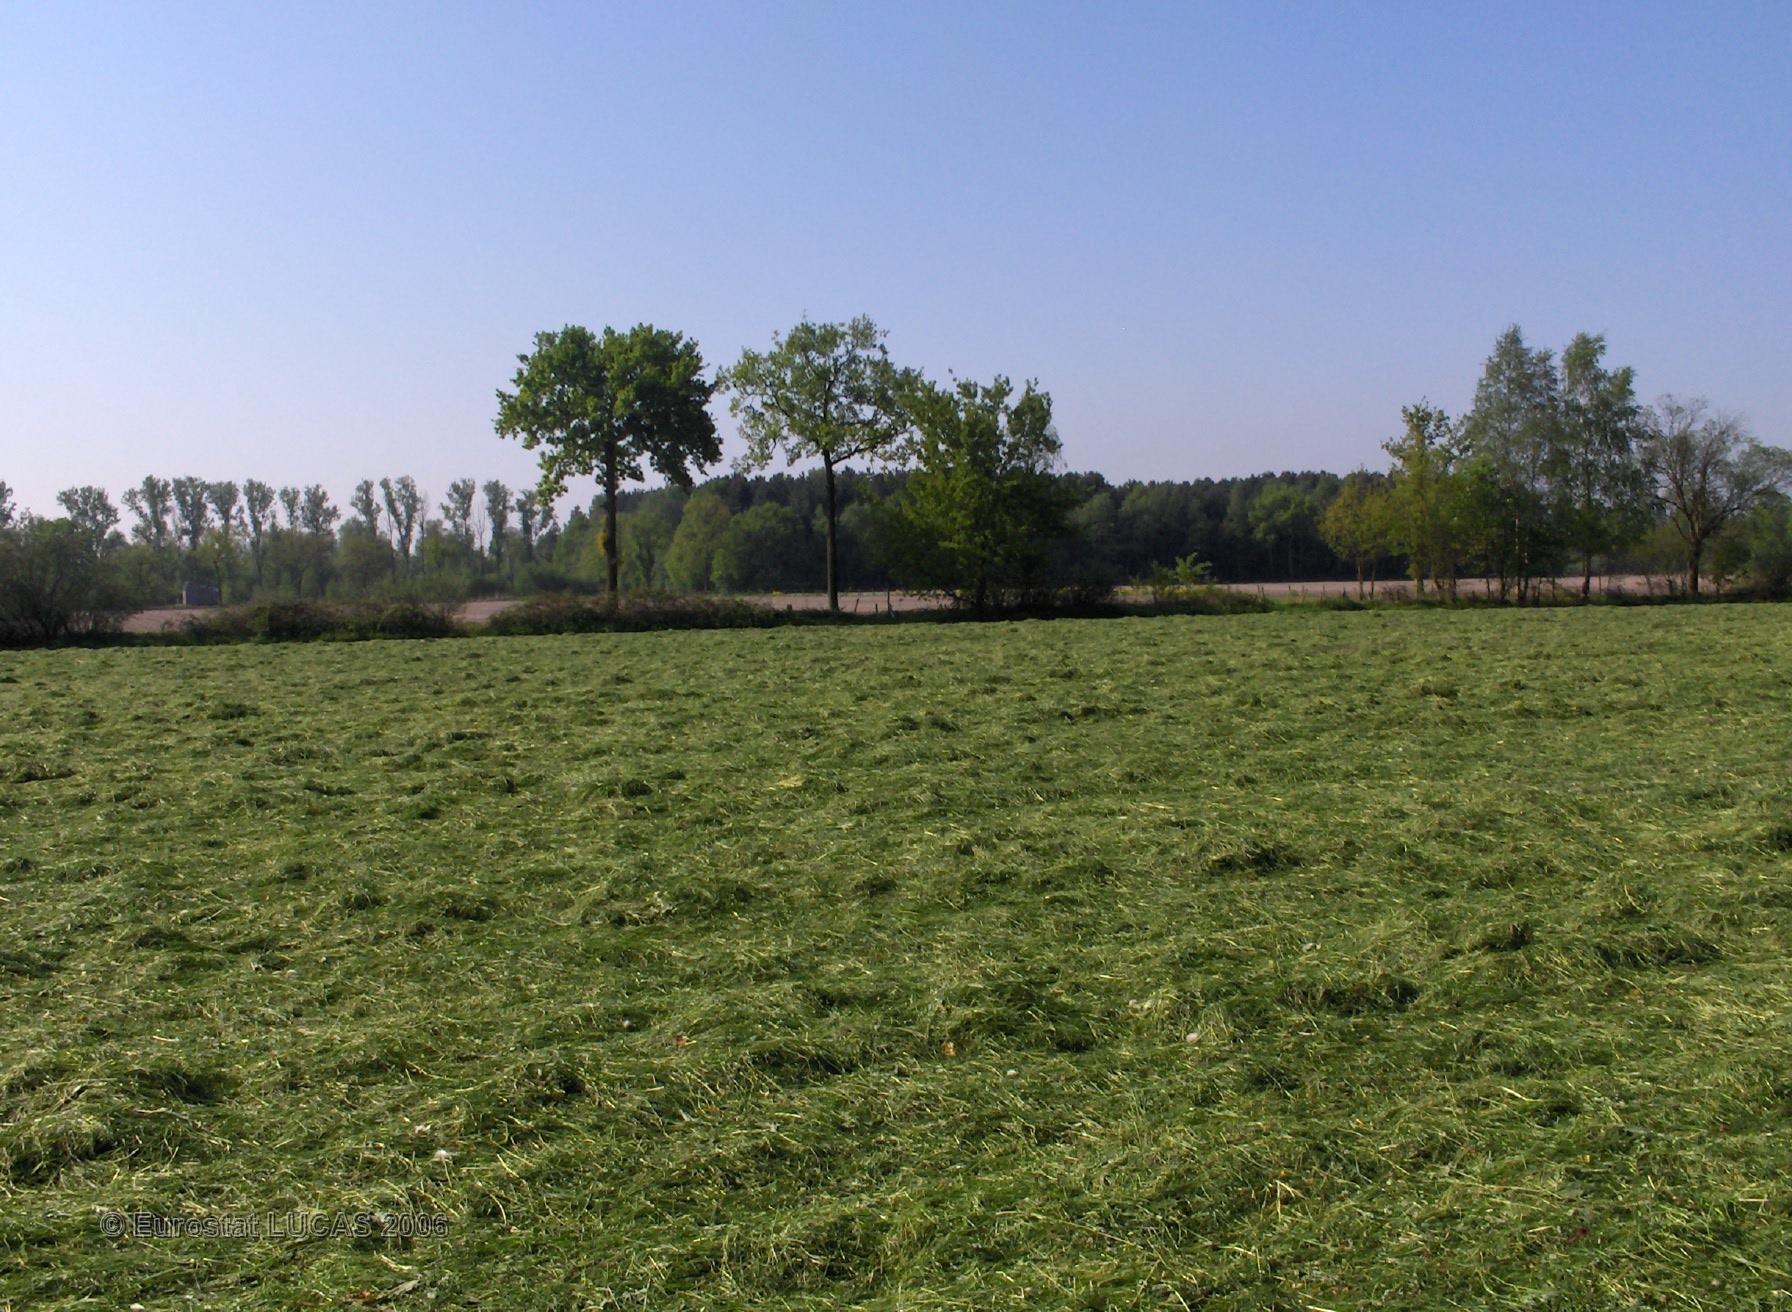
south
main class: Grassland
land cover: Grassland without tree/shrub cover
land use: Agriculture (excluding fallow land and kitchen gardens)
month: May
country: BE
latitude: 51.2874
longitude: 5.1366
